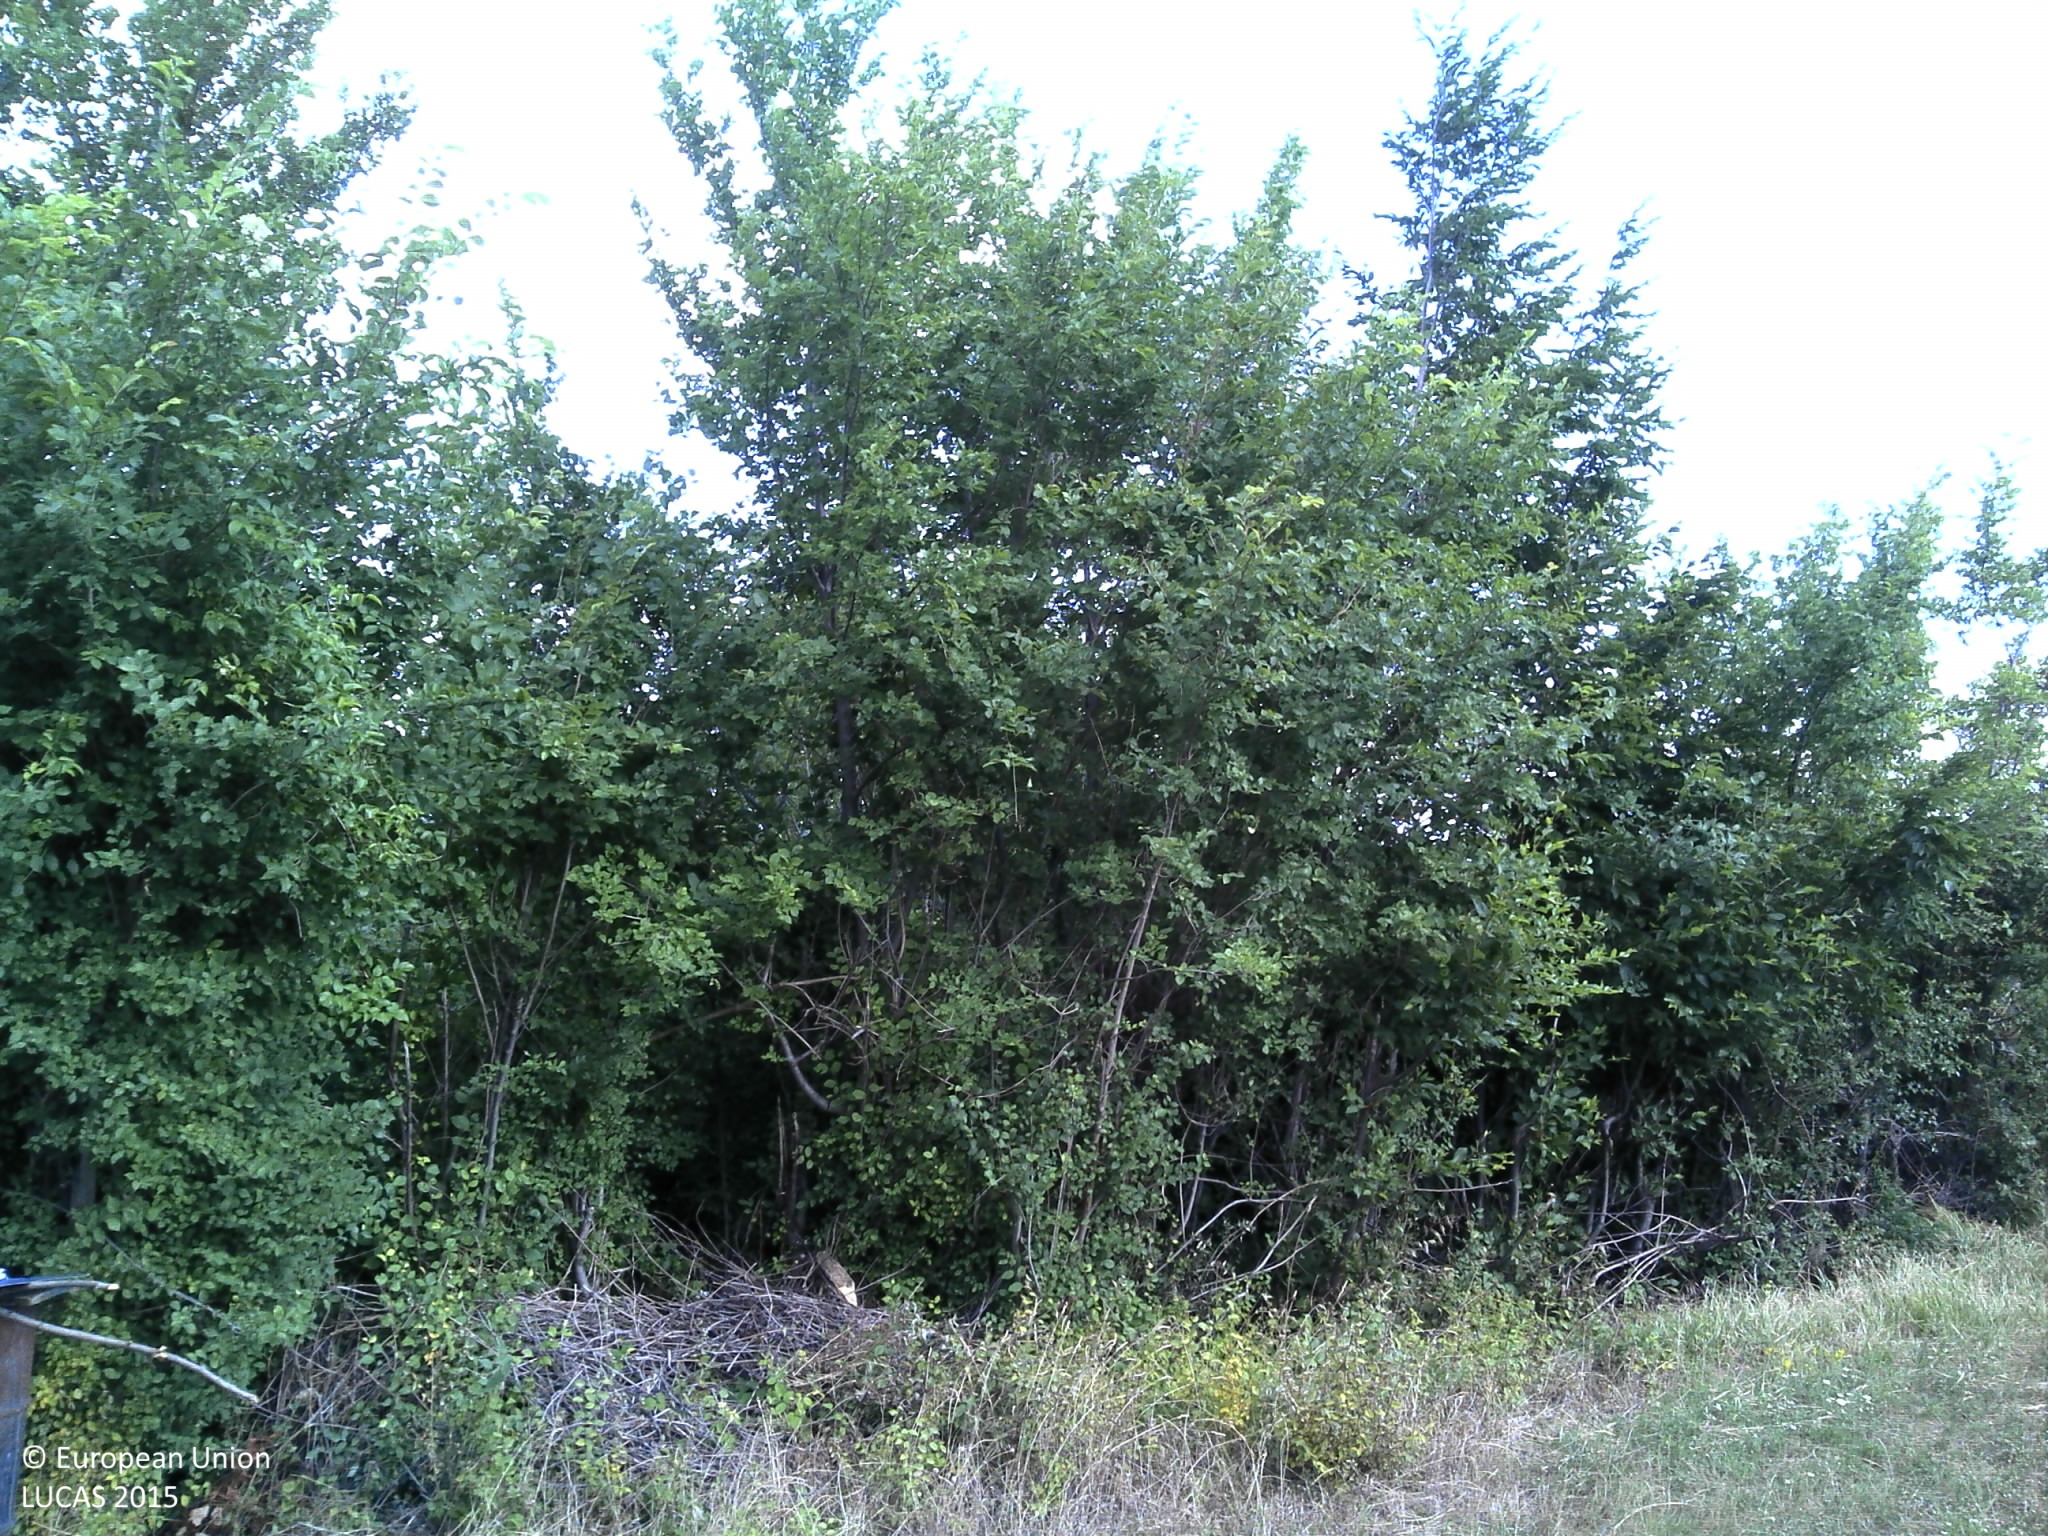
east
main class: Woodland
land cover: Broadleaved woodland
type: thermophilous deciduous forest
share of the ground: 50 - 75 %
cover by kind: broadleaved forest trees 50 %, shrubs 40 %, coniferous forest trees 10 %
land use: Semi-natural and natural areas not in use
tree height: > 5 m
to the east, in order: Broadleaved woodland; Shrubland with sparse tree cover; Broadleaved woodland; Railways; Broadleaved woodland
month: June
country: HR
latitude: 44.0748
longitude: 16.1985
